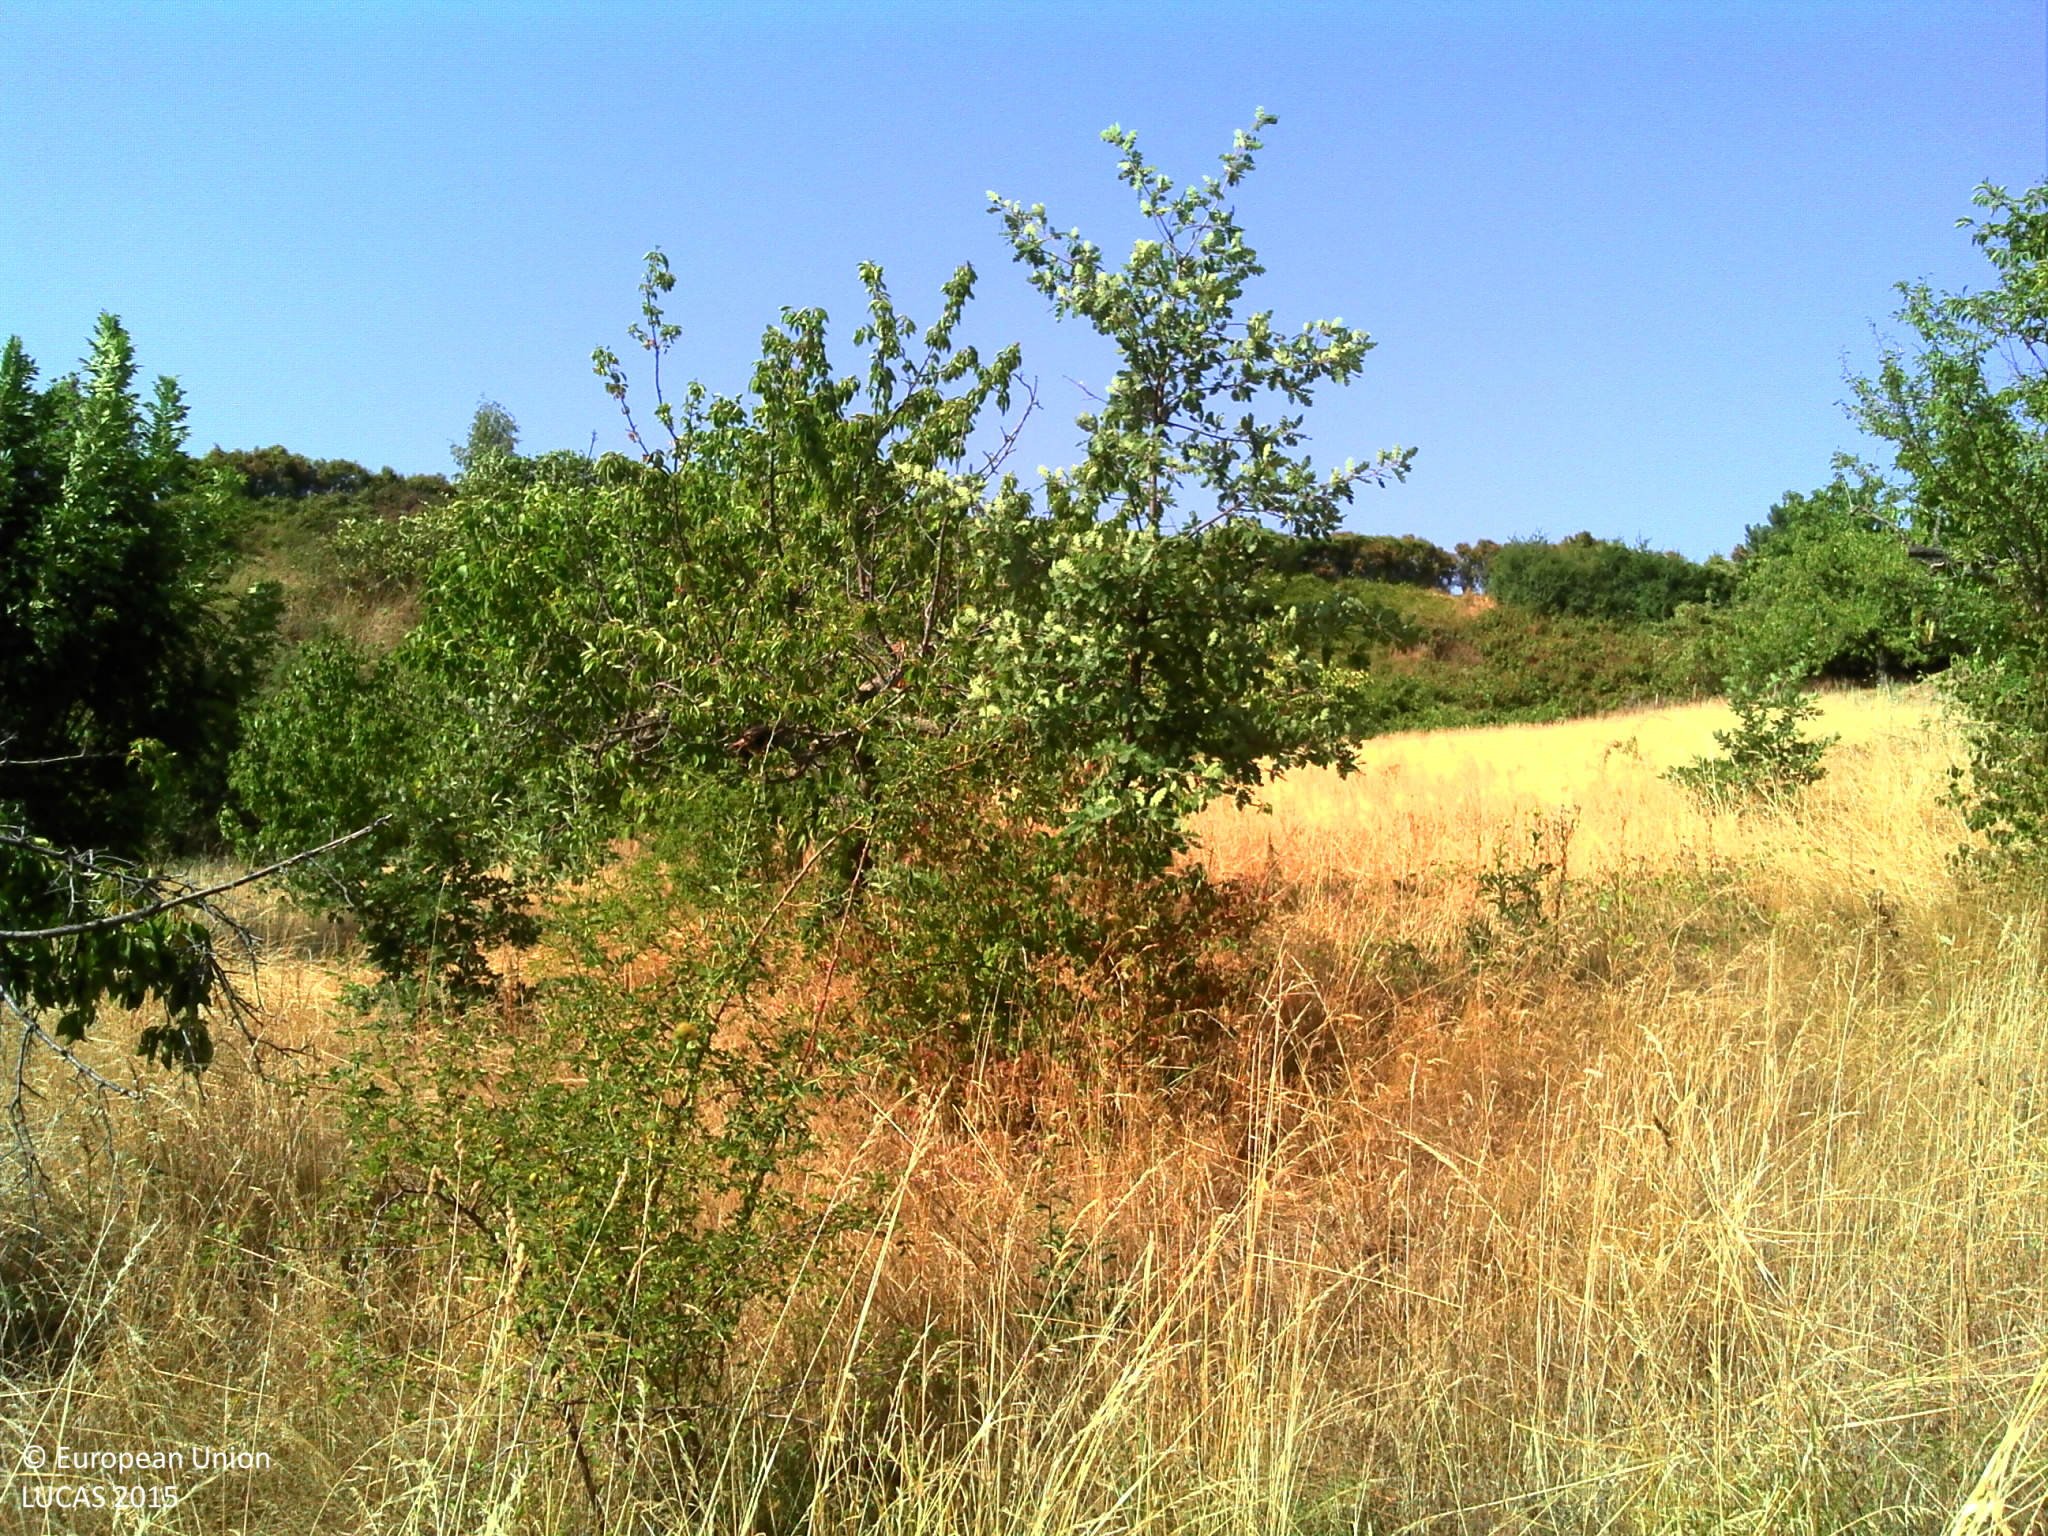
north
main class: Cropland
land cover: Apple fruit
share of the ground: 10 - 25 %
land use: Agriculture (excluding fallow land and kitchen gardens)
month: August
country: FR
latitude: 45.5461
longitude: 4.5860
